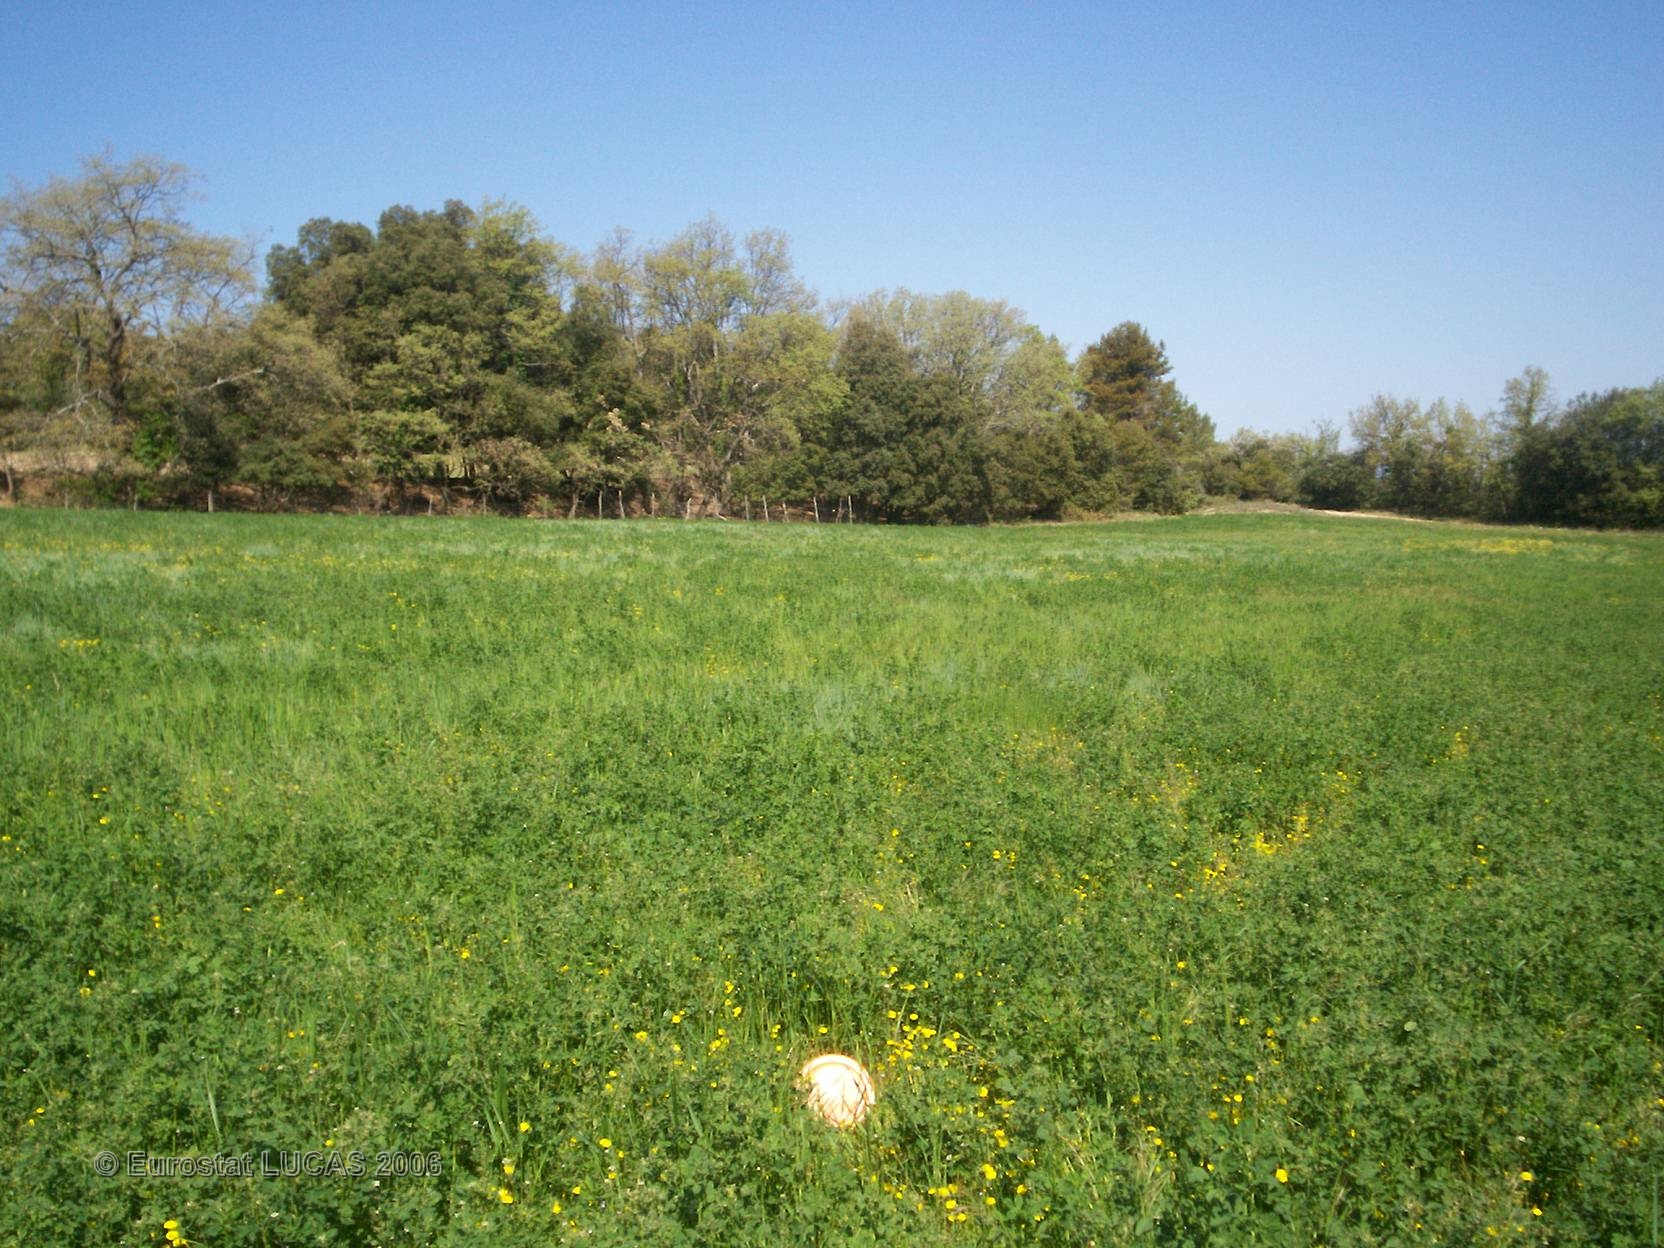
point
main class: Cropland
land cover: Lucerne
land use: Agriculture (excluding fallow land and kitchen gardens)
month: April
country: FR
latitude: 43.6084
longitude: 5.6357
